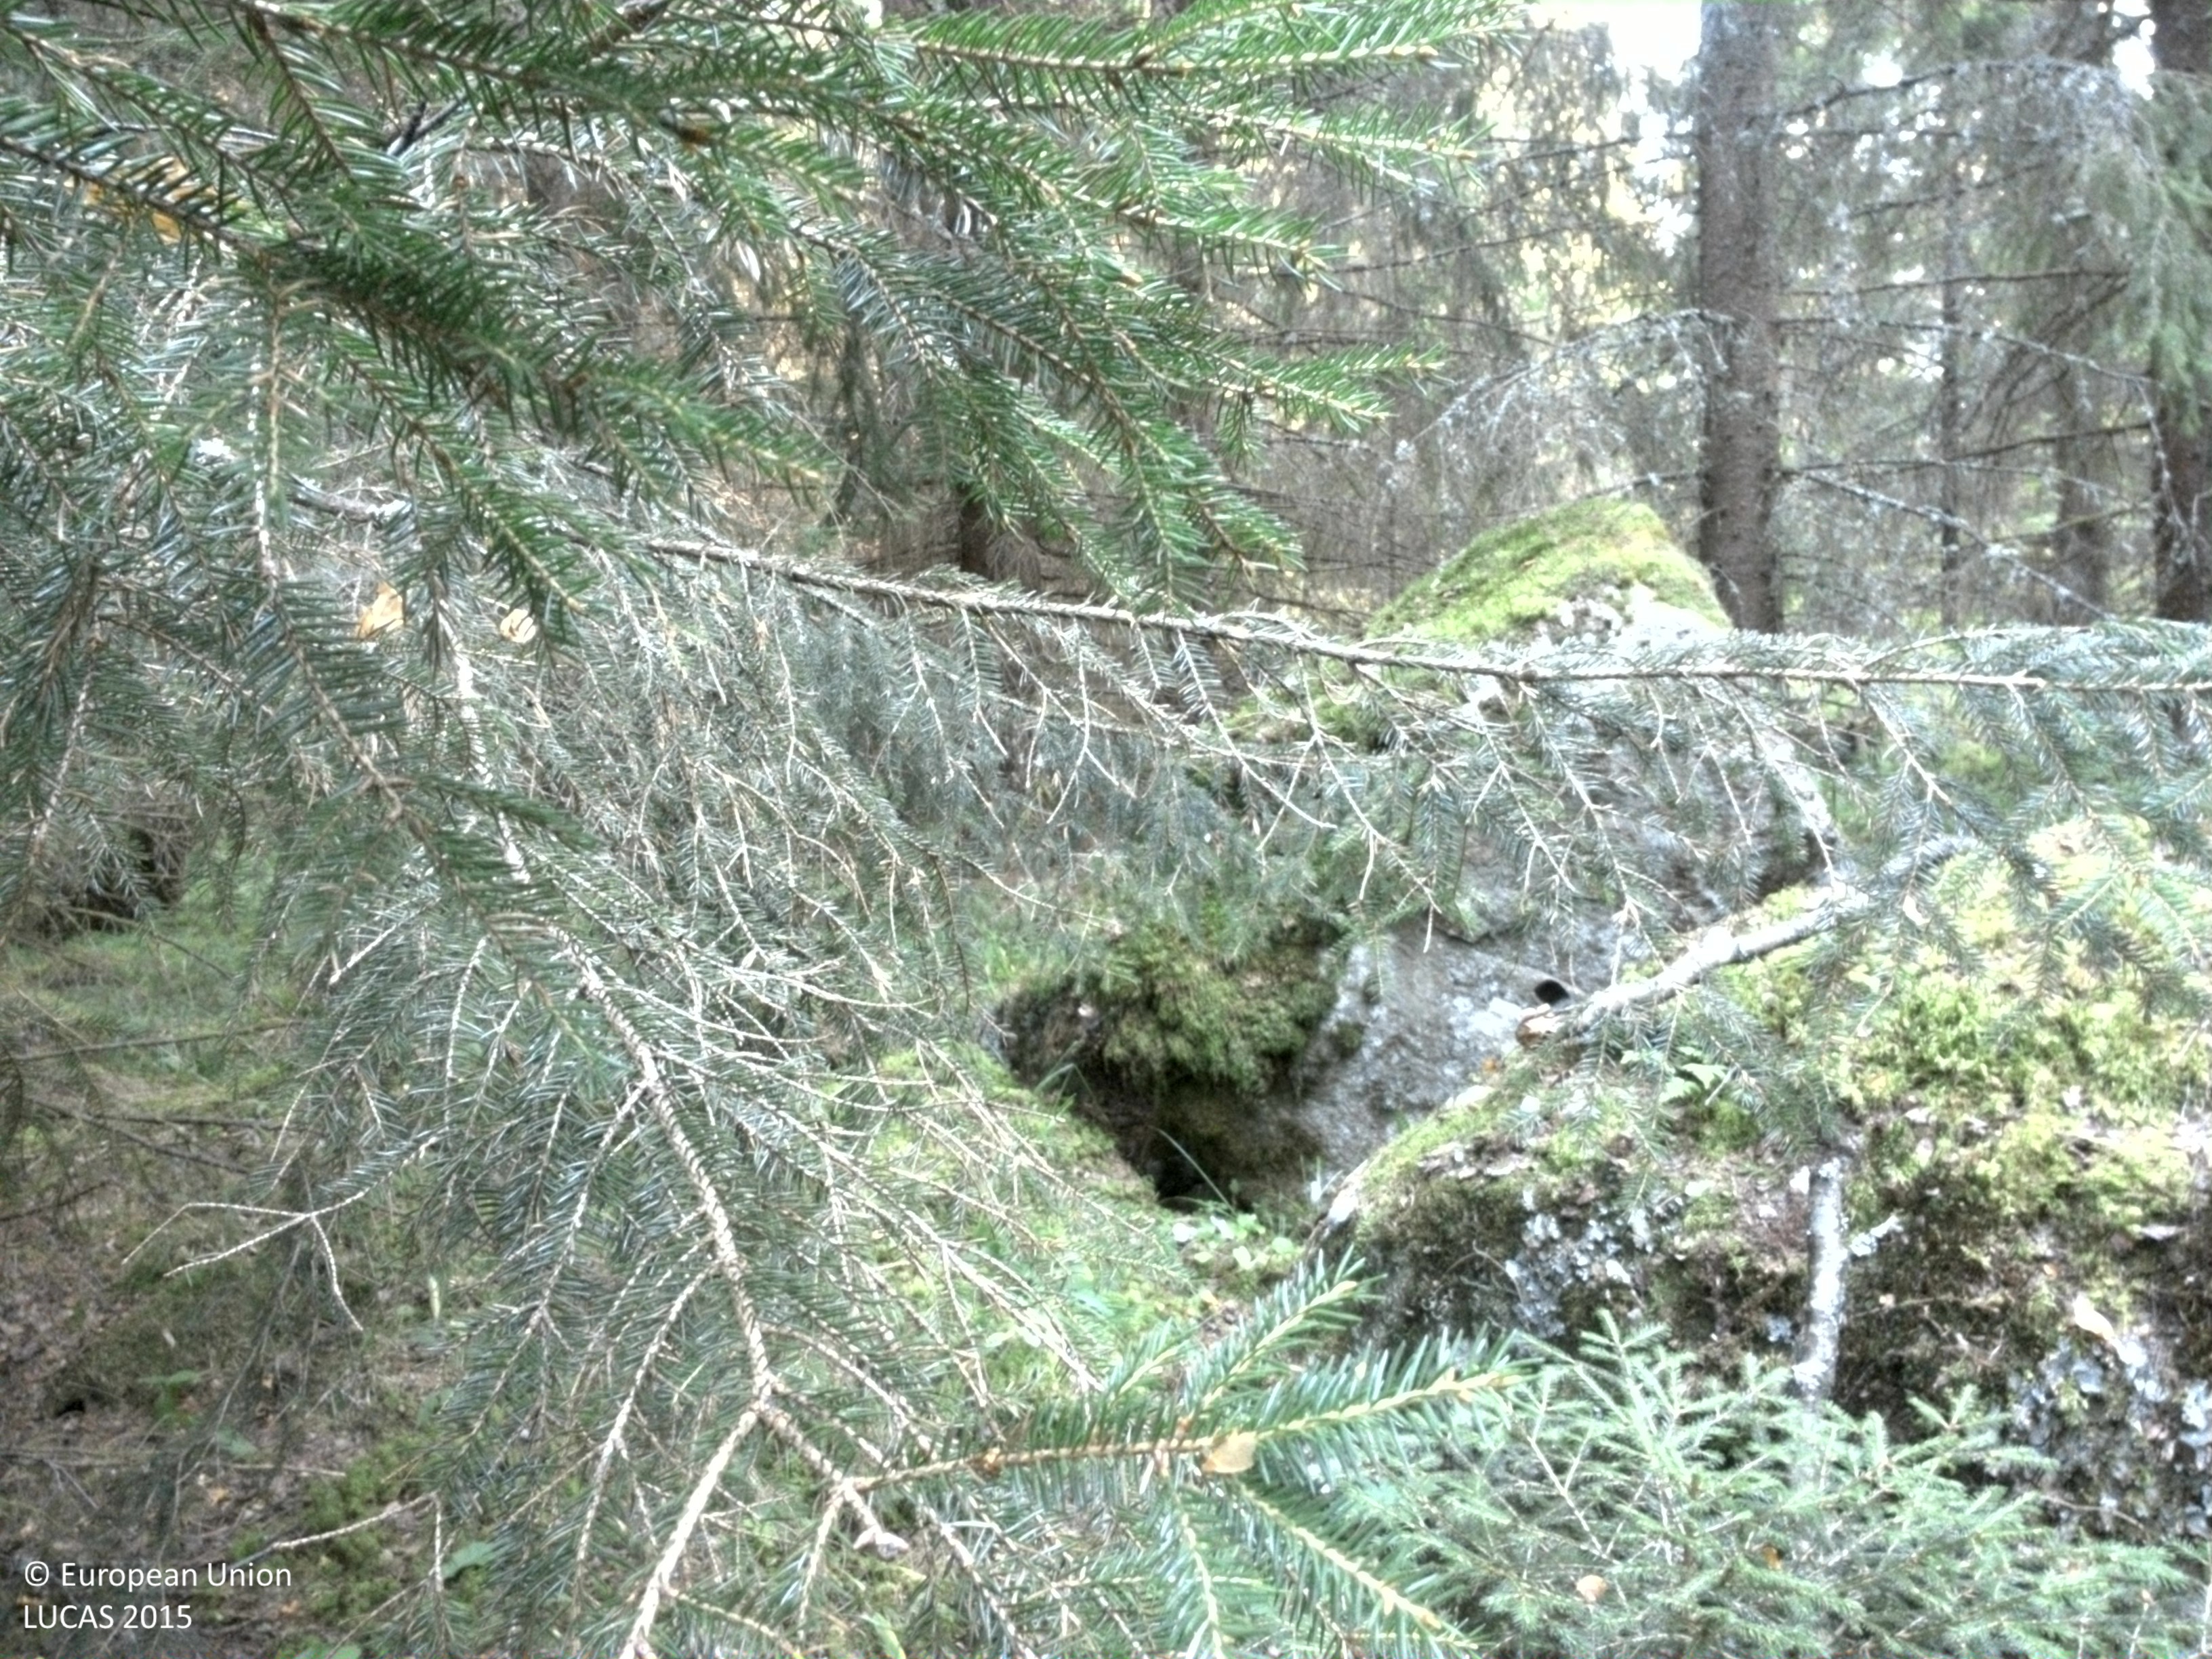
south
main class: Woodland
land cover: Spruce dominated mixed woodland
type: boreal forest
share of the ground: > 75 %
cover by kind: coniferous forest trees 55 %, broadleaved forest trees 20 %, lichens and mosses 15 %, herbaceous plants 5 %, consolidated bare surface 5 %
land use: Forestry
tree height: > 5 m
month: August
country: SE
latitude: 59.7481
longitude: 15.9520
